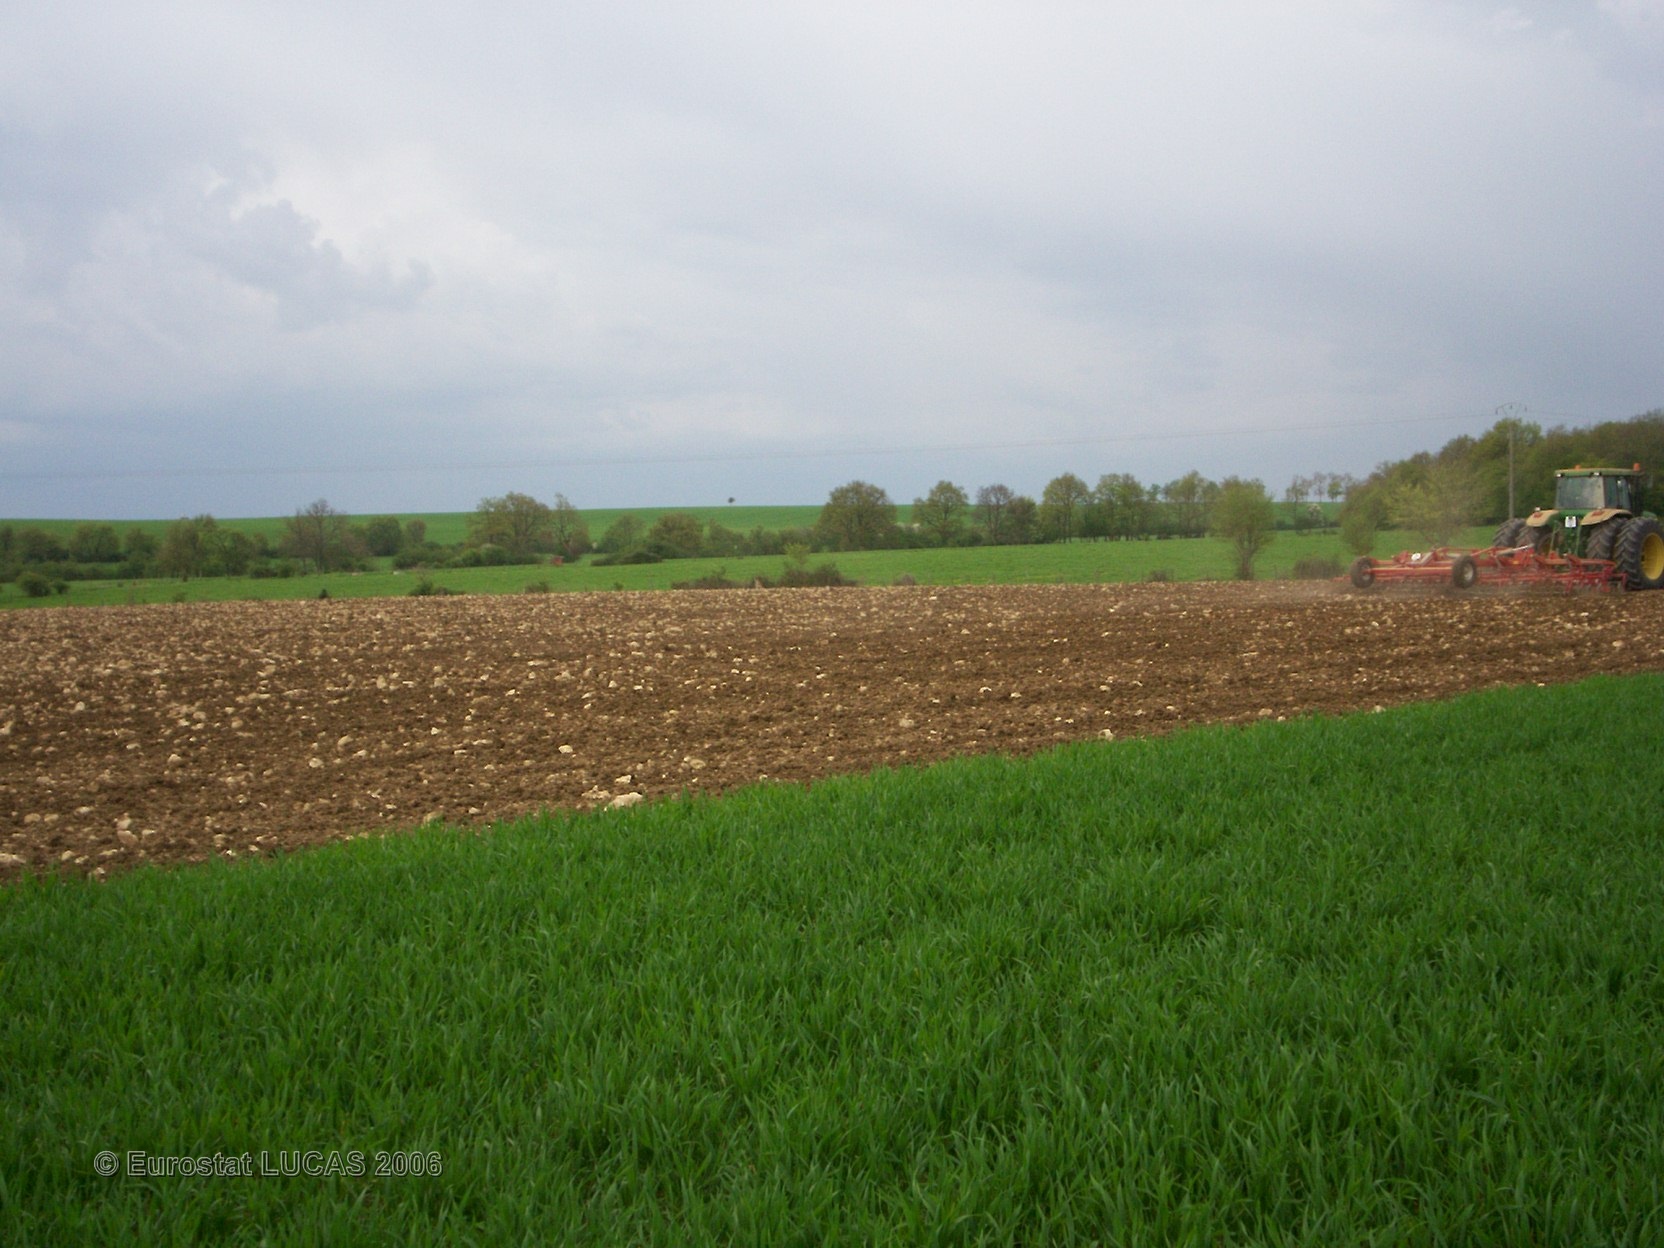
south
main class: Cropland
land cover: Common wheat
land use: Agriculture (excluding fallow land and kitchen gardens)
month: April
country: FR
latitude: 47.3126
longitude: 2.9704
